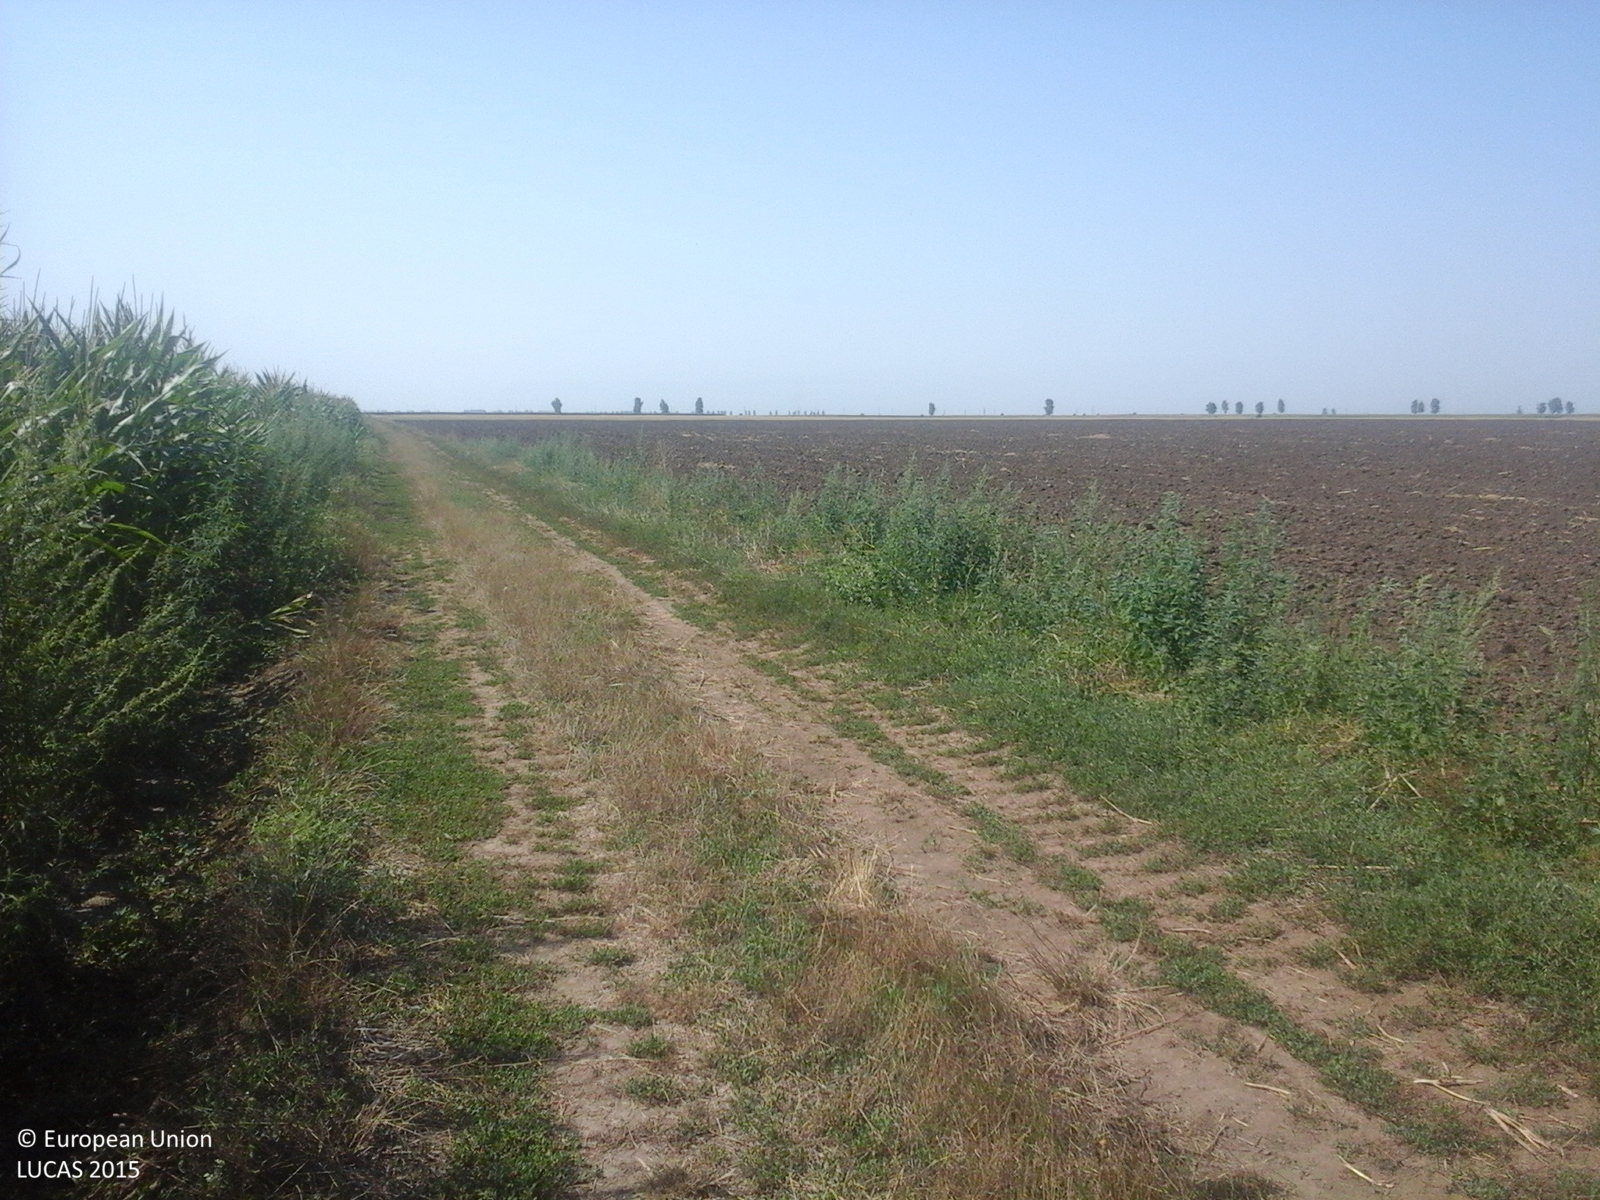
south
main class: Cropland
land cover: Maize
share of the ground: > 75 %
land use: Agriculture (excluding fallow land and kitchen gardens)
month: July
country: RO
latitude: 44.8276
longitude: 27.5648
